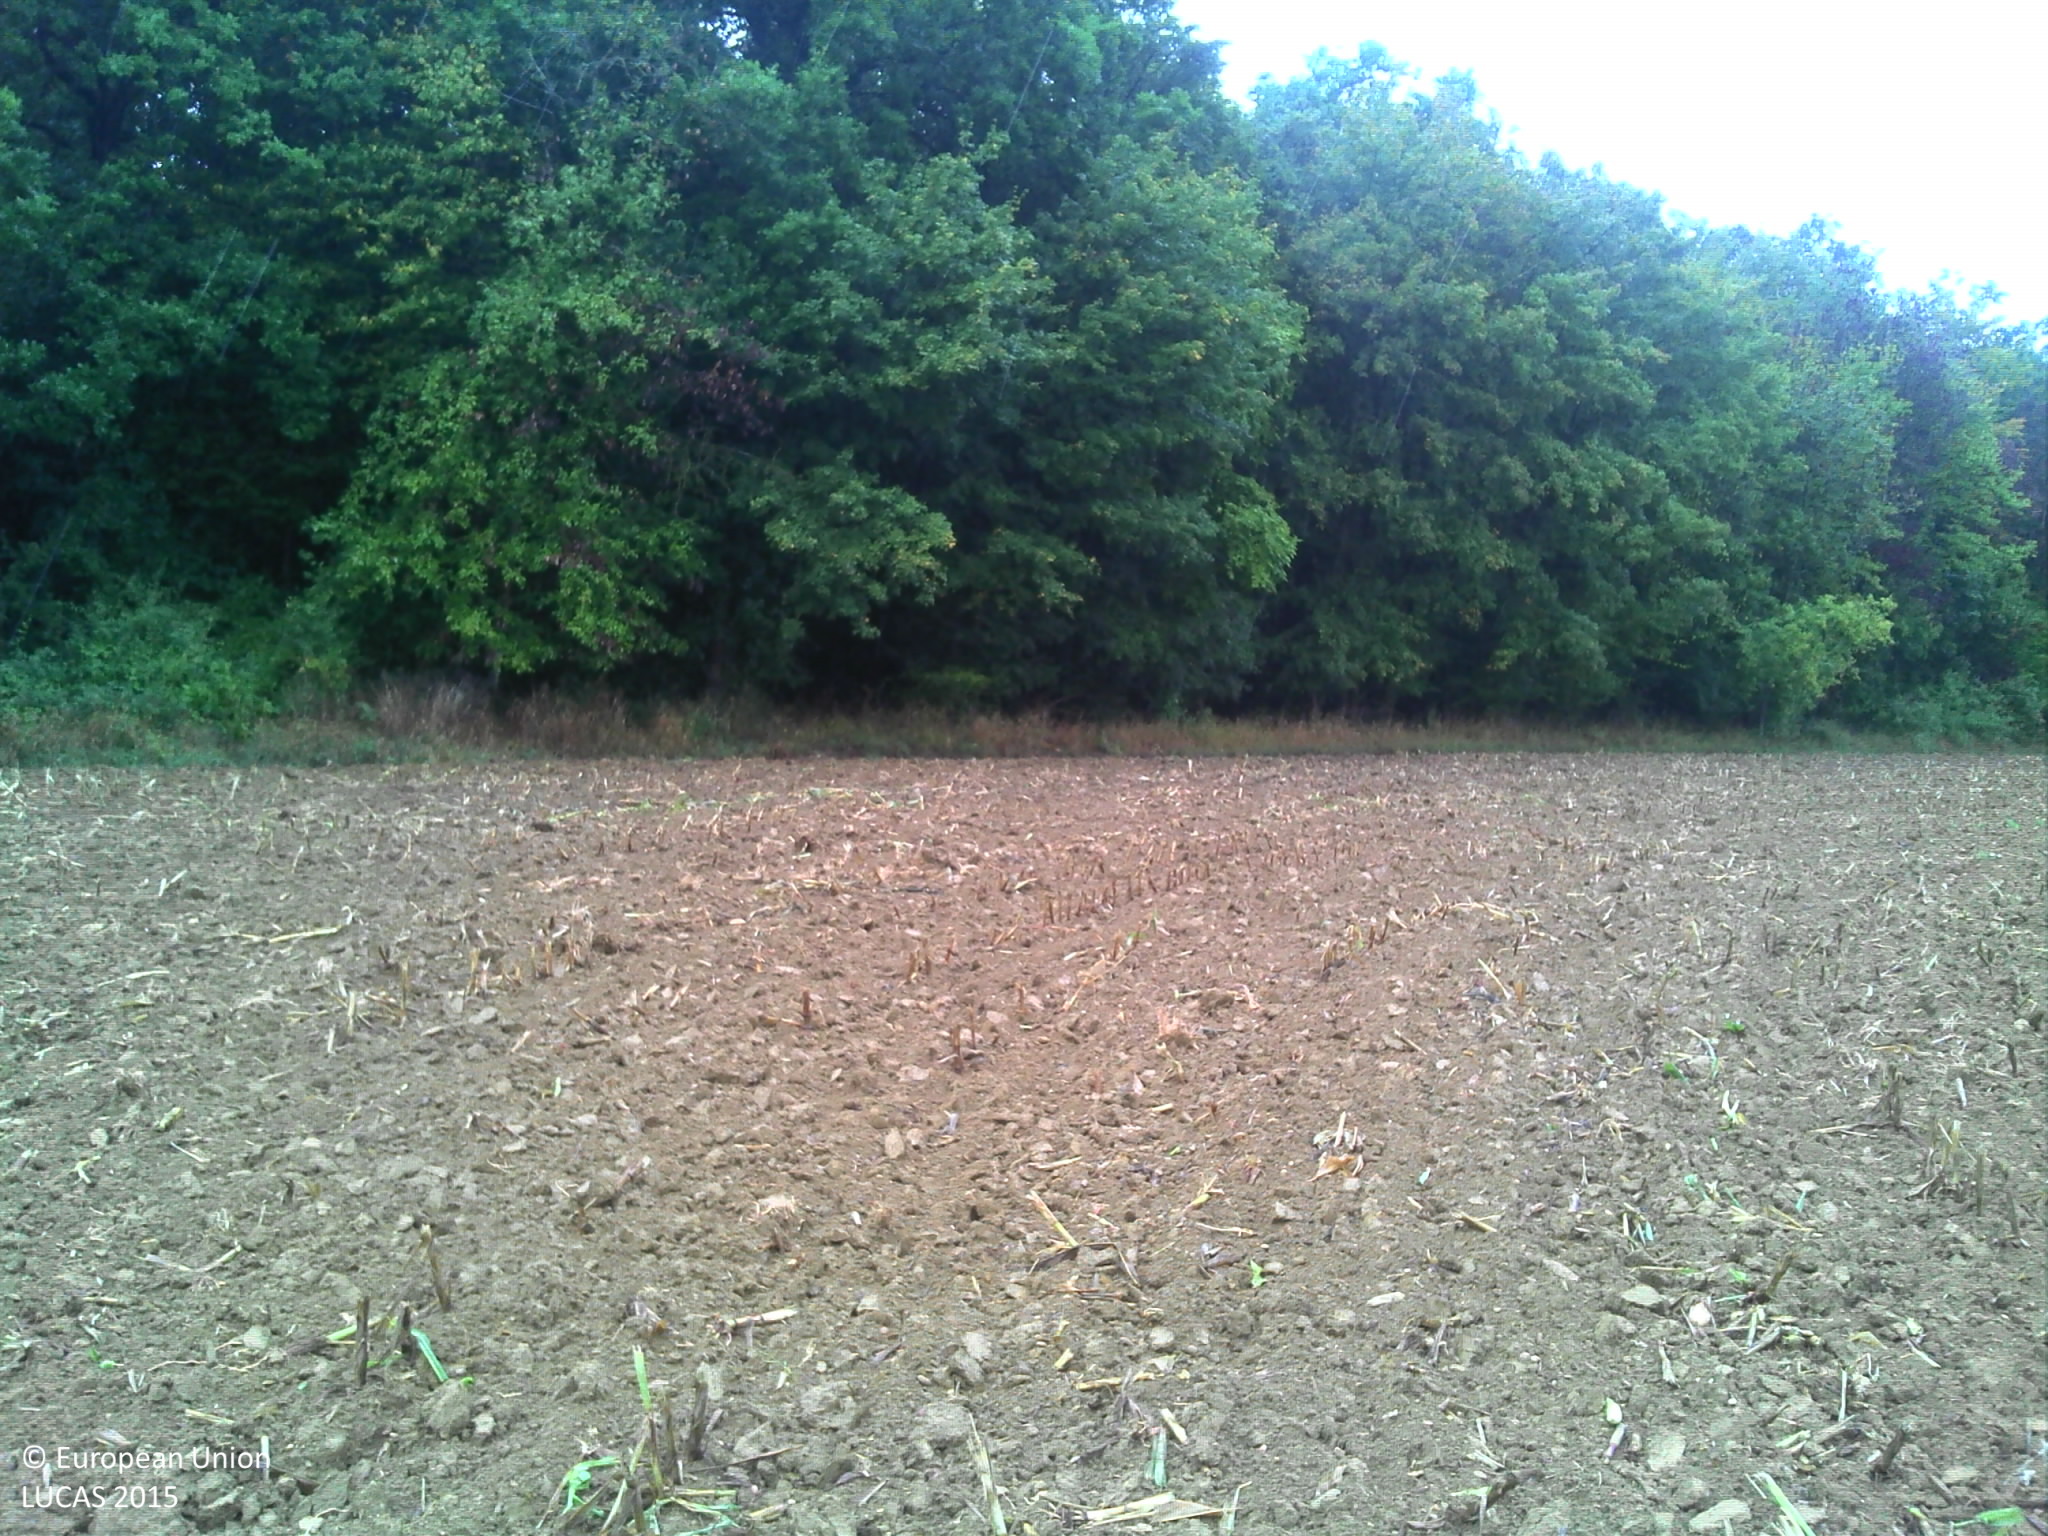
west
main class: Cropland
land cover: Maize
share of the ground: < 10 %
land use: Agriculture (excluding fallow land and kitchen gardens)
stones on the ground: < 10 %
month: September
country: FR
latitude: 49.2269
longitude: 5.8661
